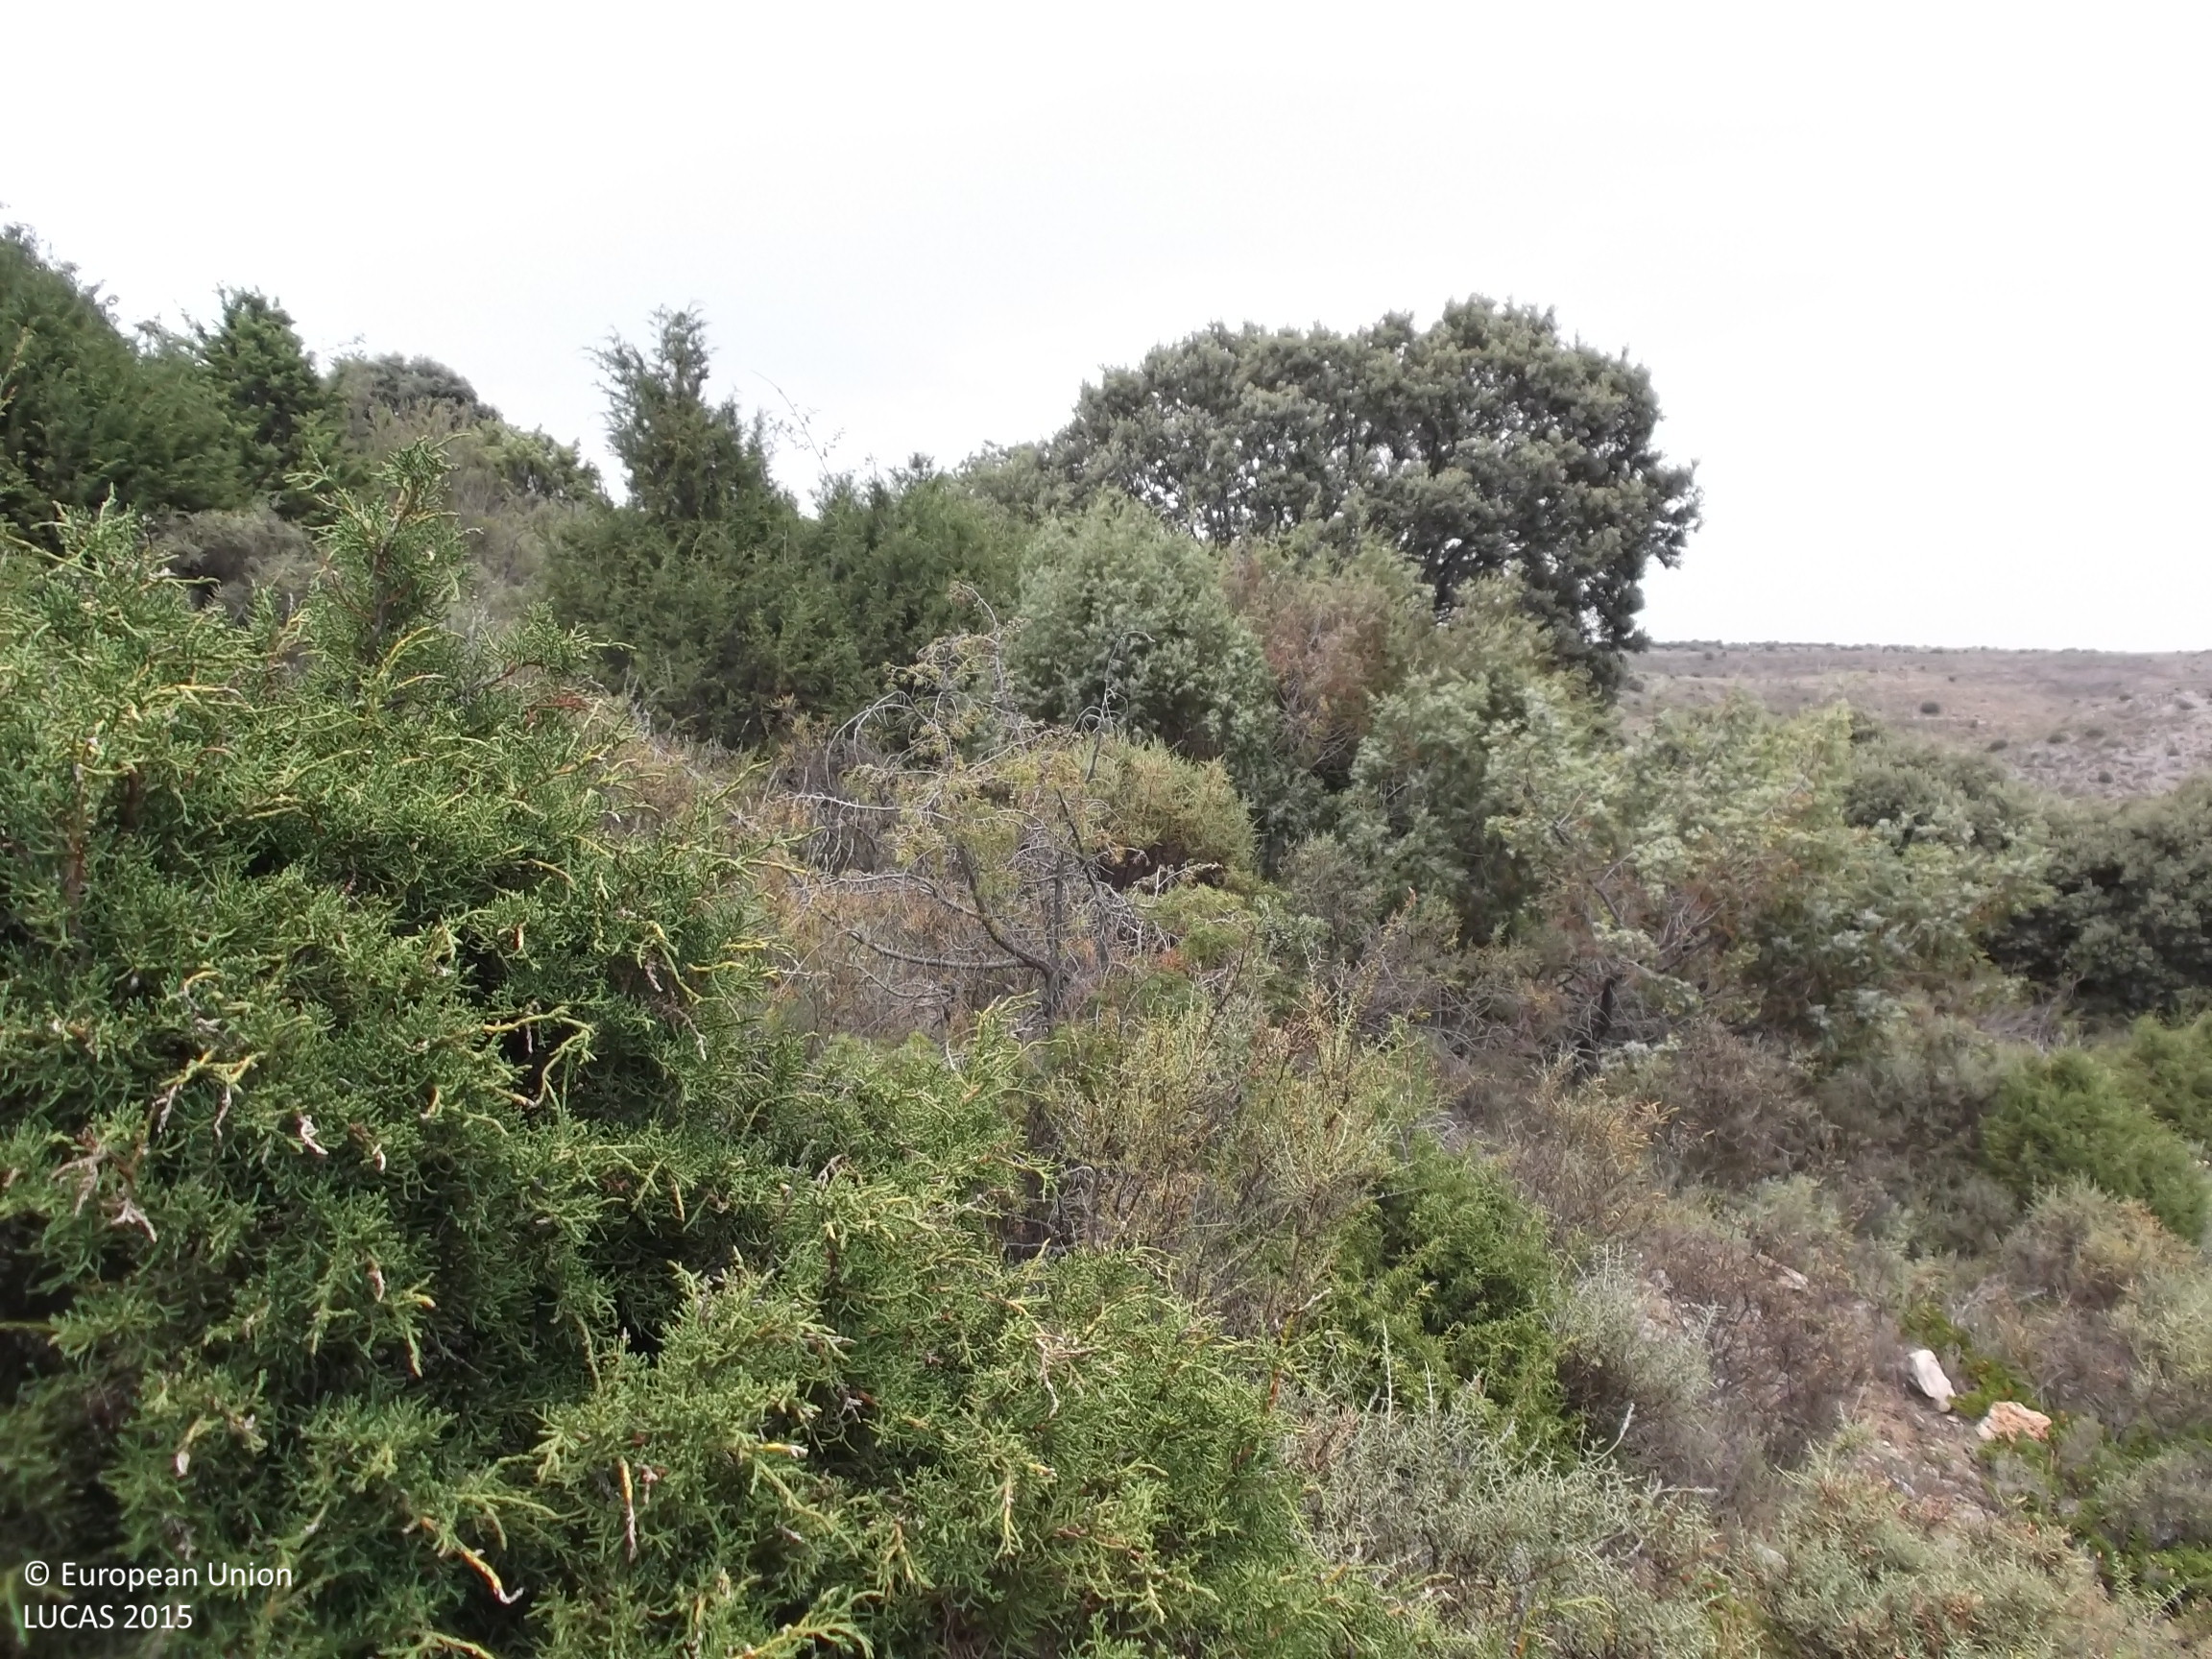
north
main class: Woodland
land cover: Other coniferous woodland
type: coniferous forest of the mediterranean region
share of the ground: 10 - 25 %
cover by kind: shrubs 70 %, coniferous forest trees 15 %, herbaceous plants 10 %, broadleaved forest trees 5 %
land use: Semi-natural and natural areas not in use
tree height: < 5 m
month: July
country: ES
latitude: 41.9038
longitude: -1.9802
